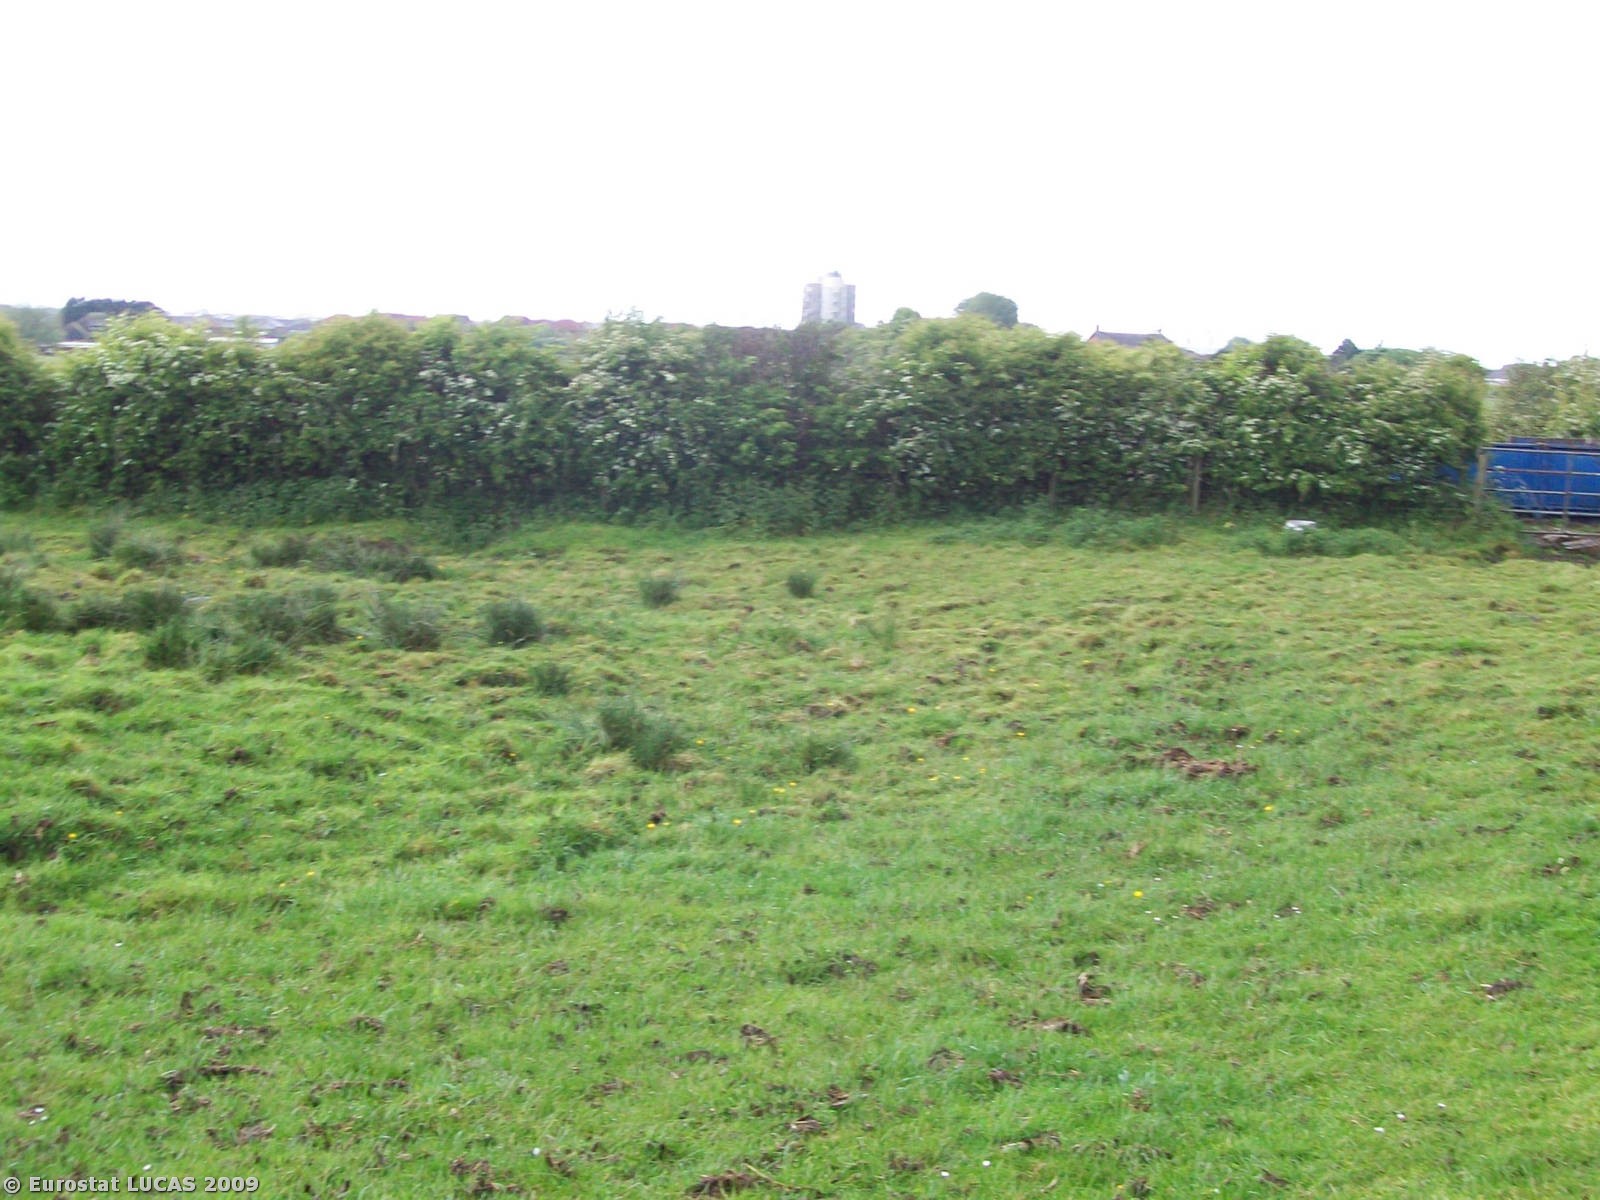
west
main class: Grassland
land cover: Grassland without tree/shrub cover
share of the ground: > 75 %
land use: Agriculture (excluding fallow land and kitchen gardens)
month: May
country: GB
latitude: 53.8622
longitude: -3.0137
